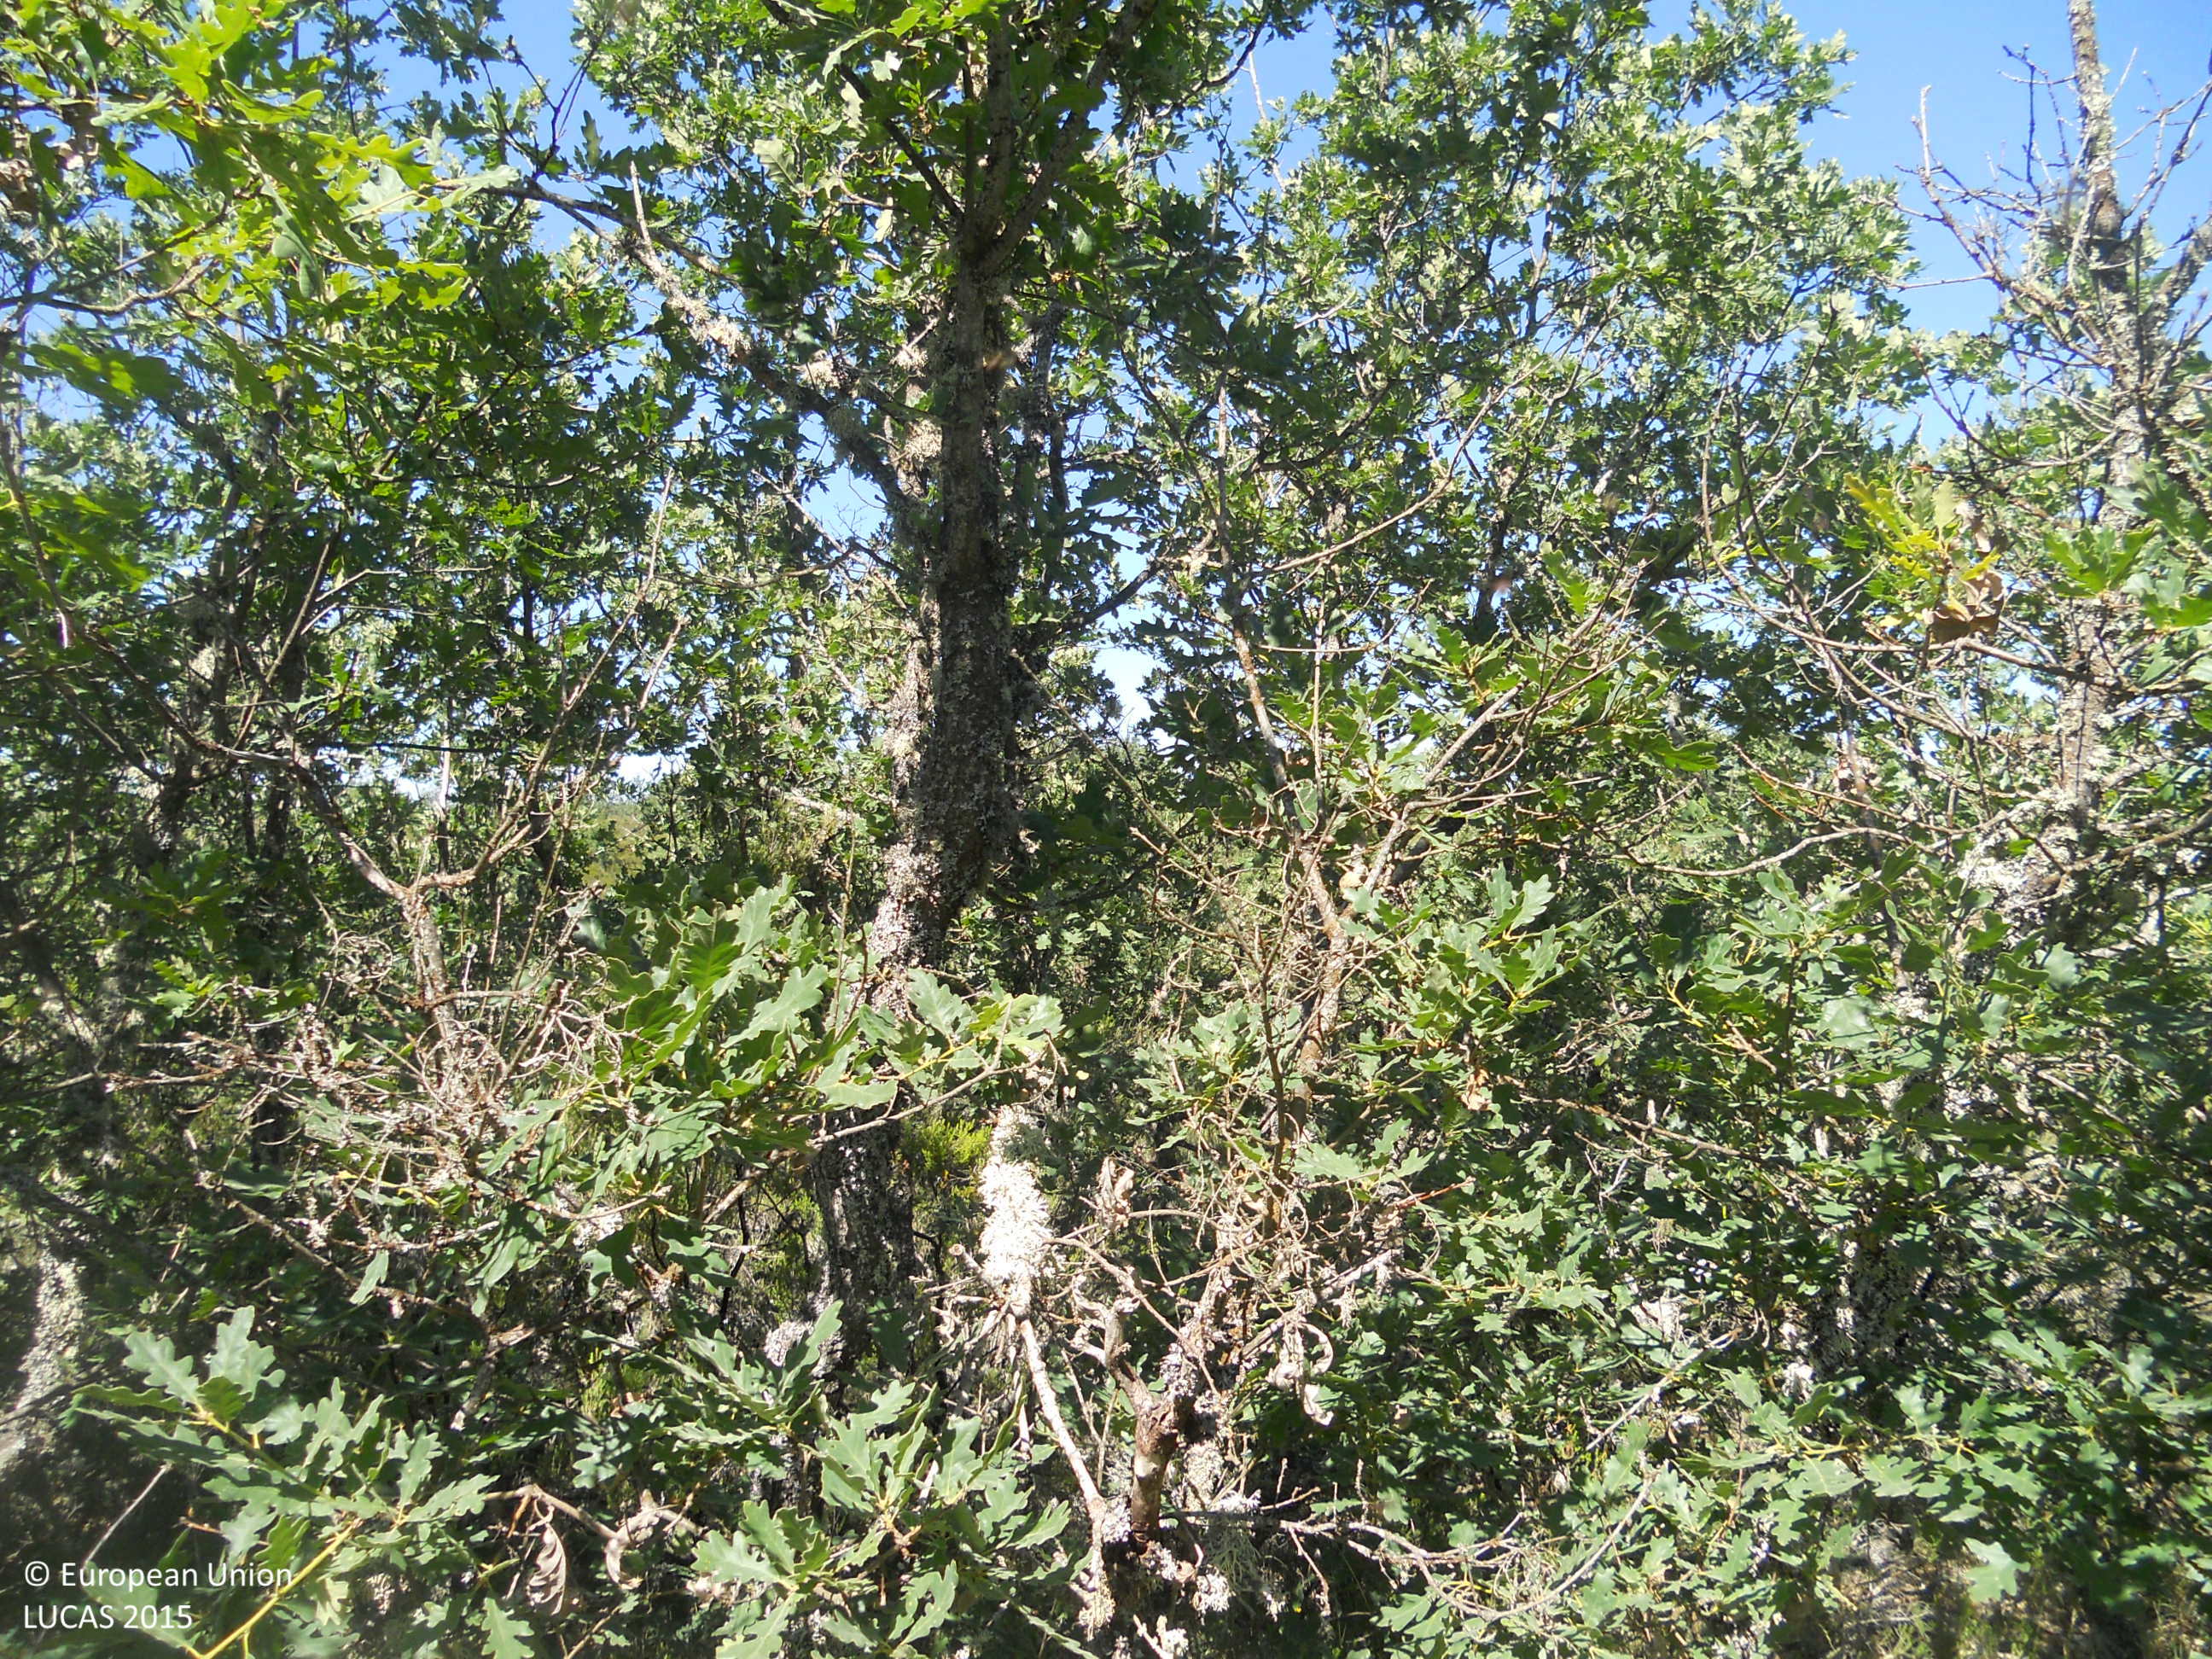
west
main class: Woodland
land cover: Broadleaved woodland
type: acidophilous oak and oak-birch forest
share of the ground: 50 - 75 %
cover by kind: broadleaved forest trees 70 %, shrubs 25 %, herbaceous plants 5 %
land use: Forestry
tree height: > 5 m
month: June
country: ES
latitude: 42.6194
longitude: -4.9467
